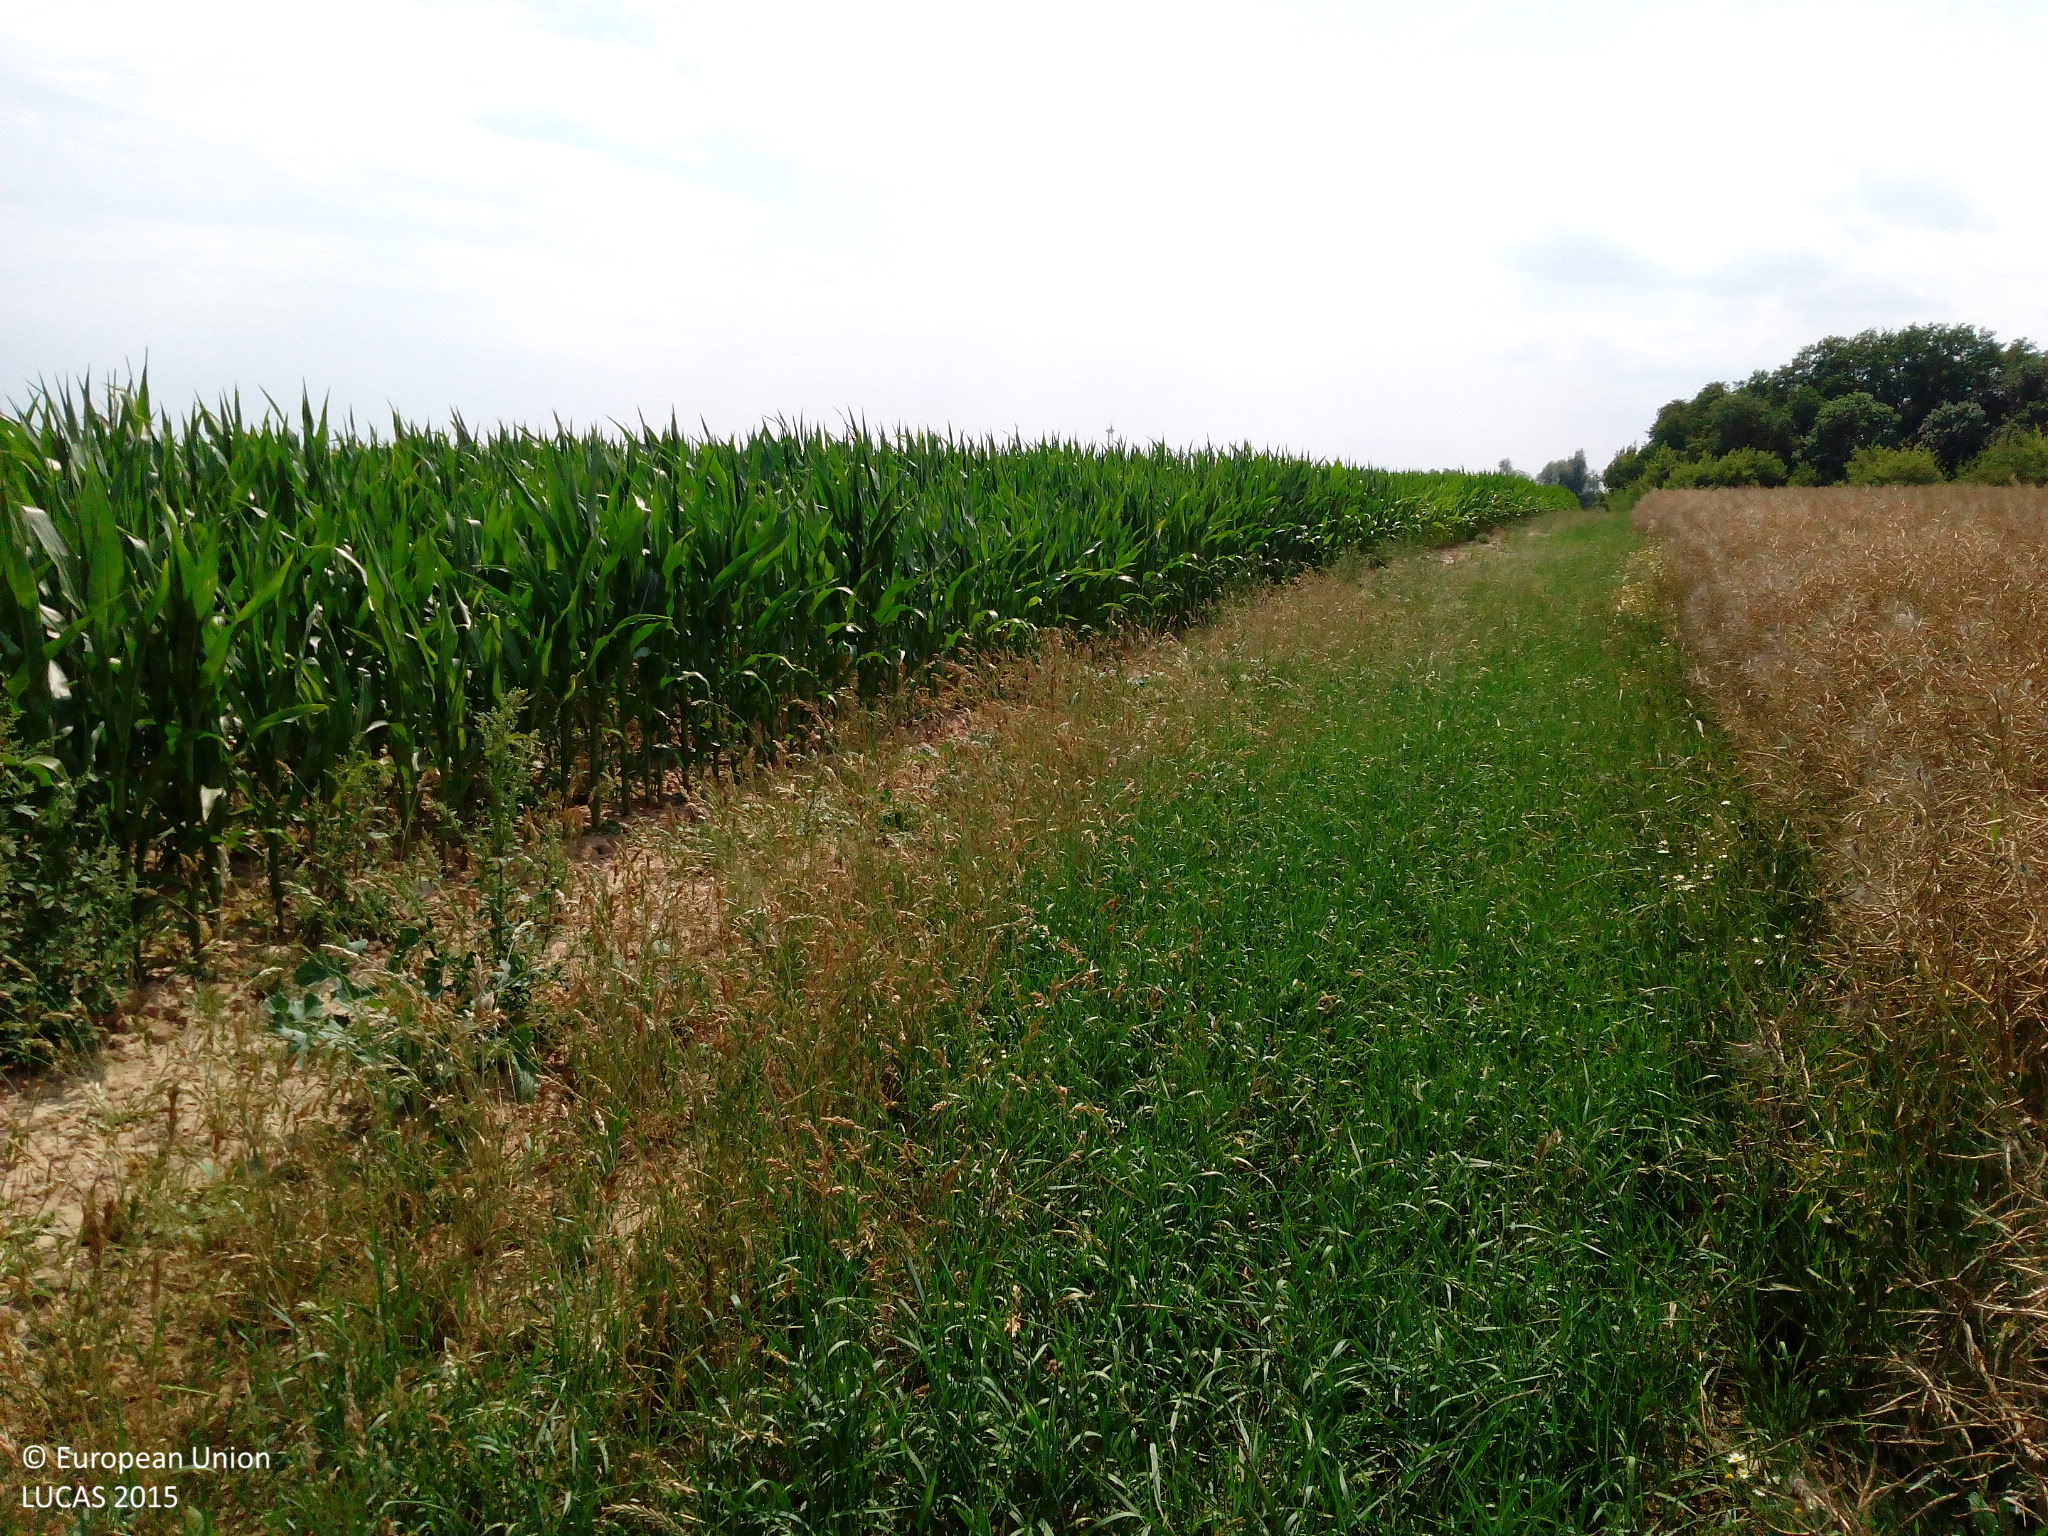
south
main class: Cropland
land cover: Rape and turnip rape
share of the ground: > 75 %
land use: Agriculture (excluding fallow land and kitchen gardens)
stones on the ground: < 10 %
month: July
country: DE
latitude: 52.4654
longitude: 14.1960
